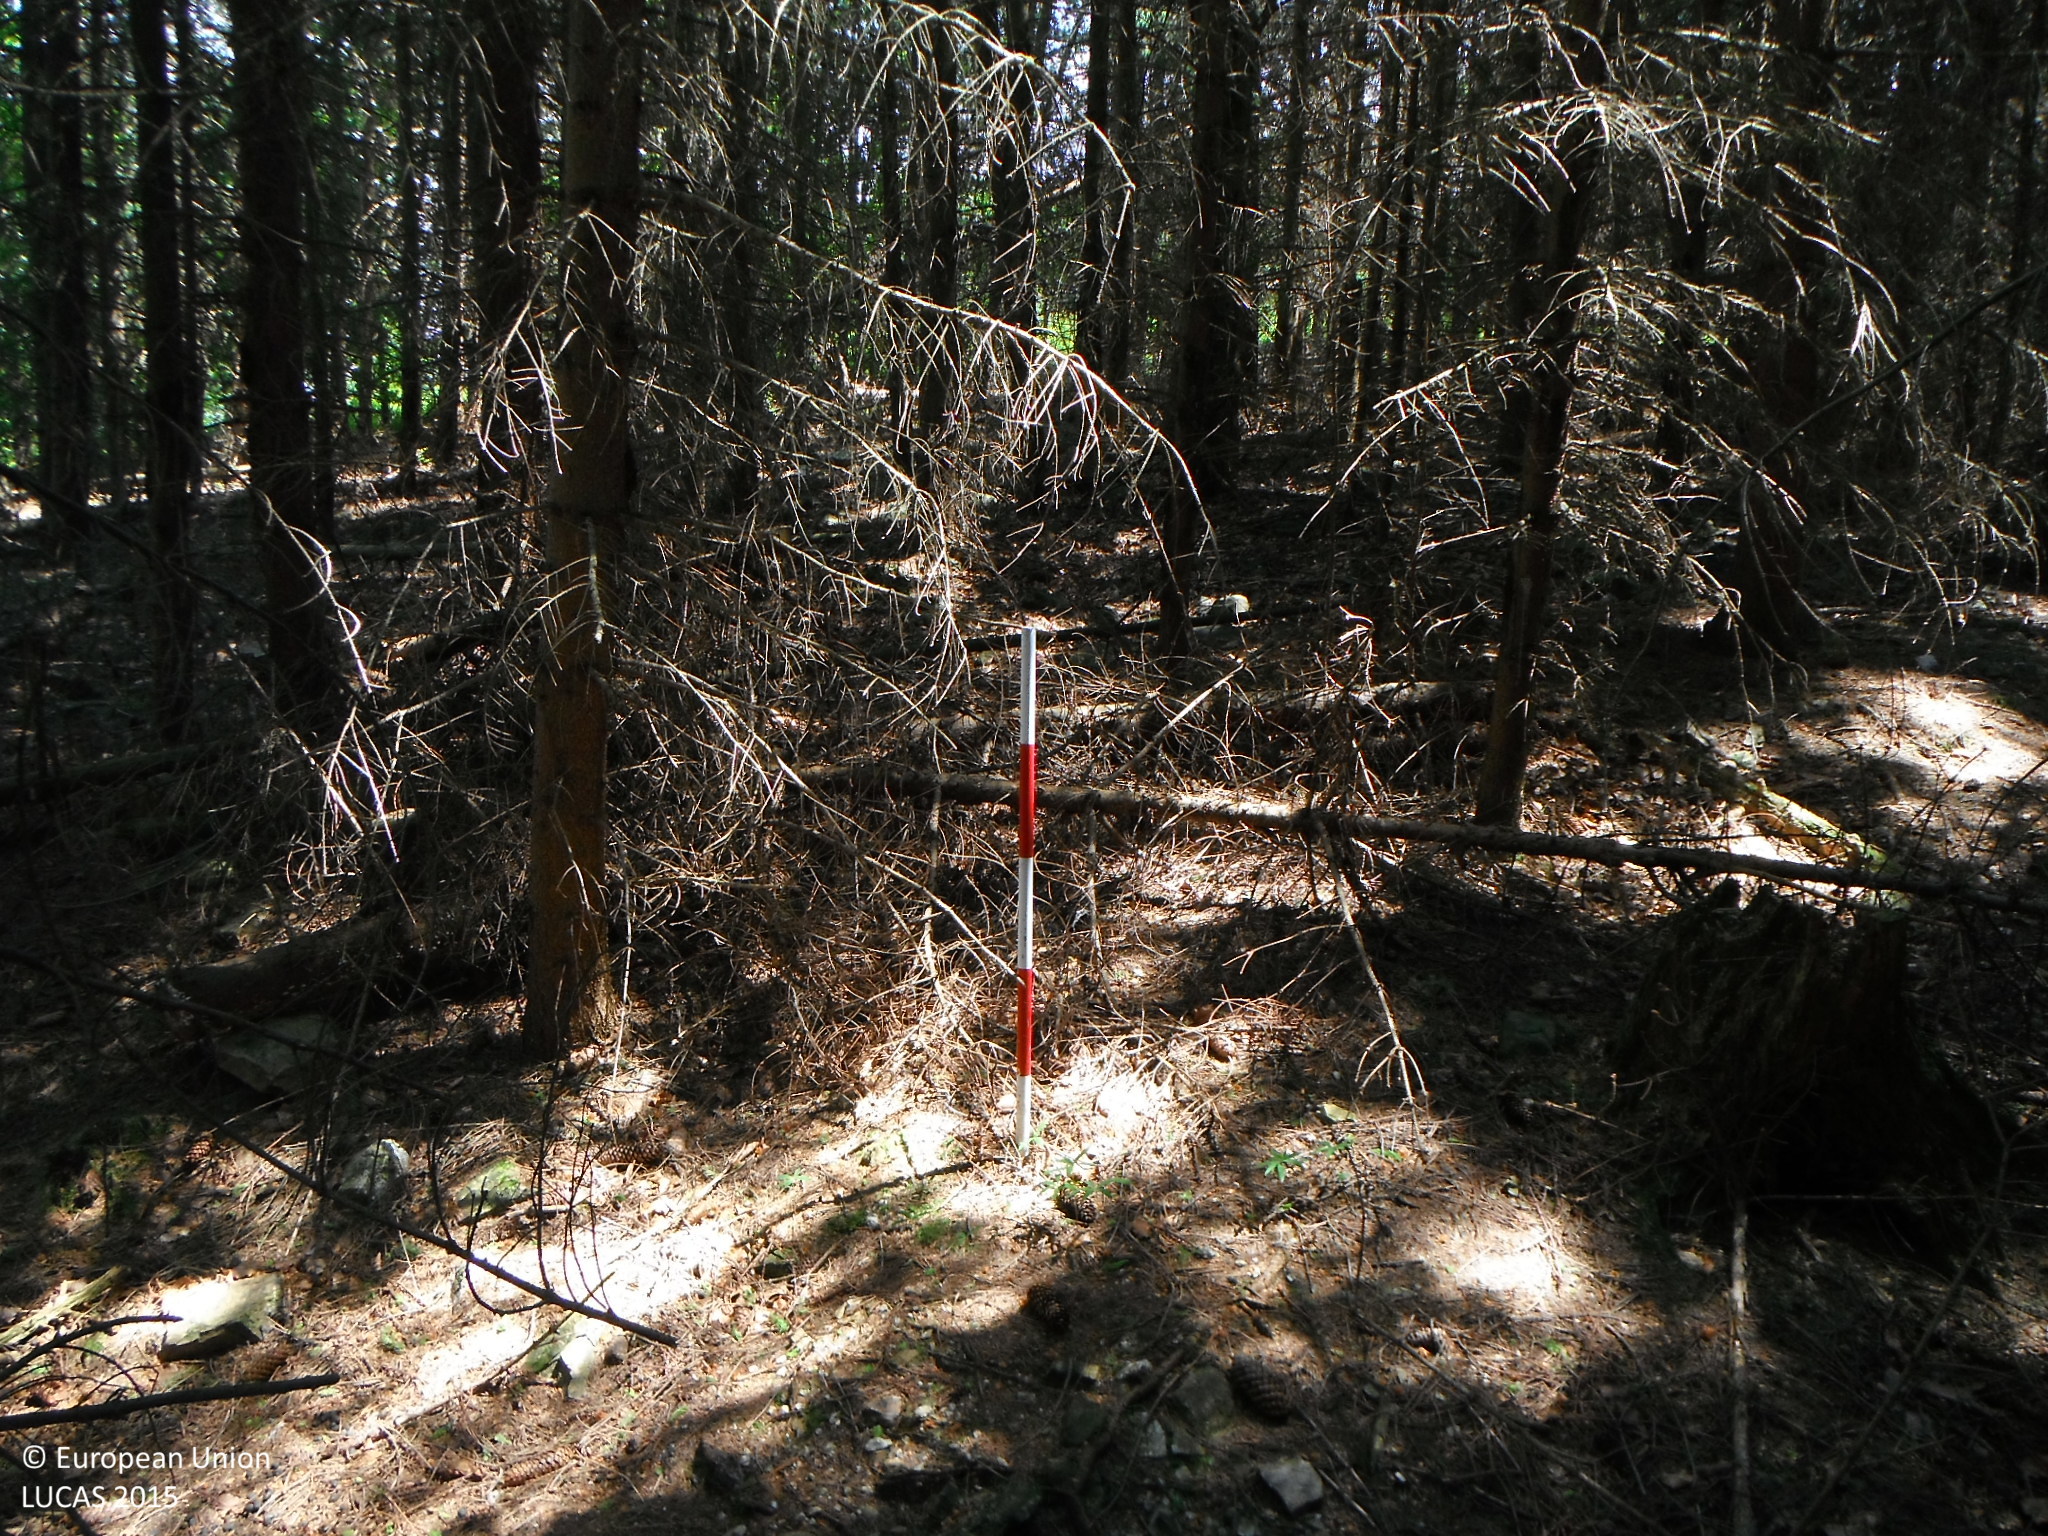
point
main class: Woodland
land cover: Spruce dominated coniferous woodland
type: alpine coniferous forest
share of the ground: > 75 %
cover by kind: coniferous forest trees 100 %
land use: Forestry
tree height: > 5 m
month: June
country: SK
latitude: 48.7142
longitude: 19.3338
